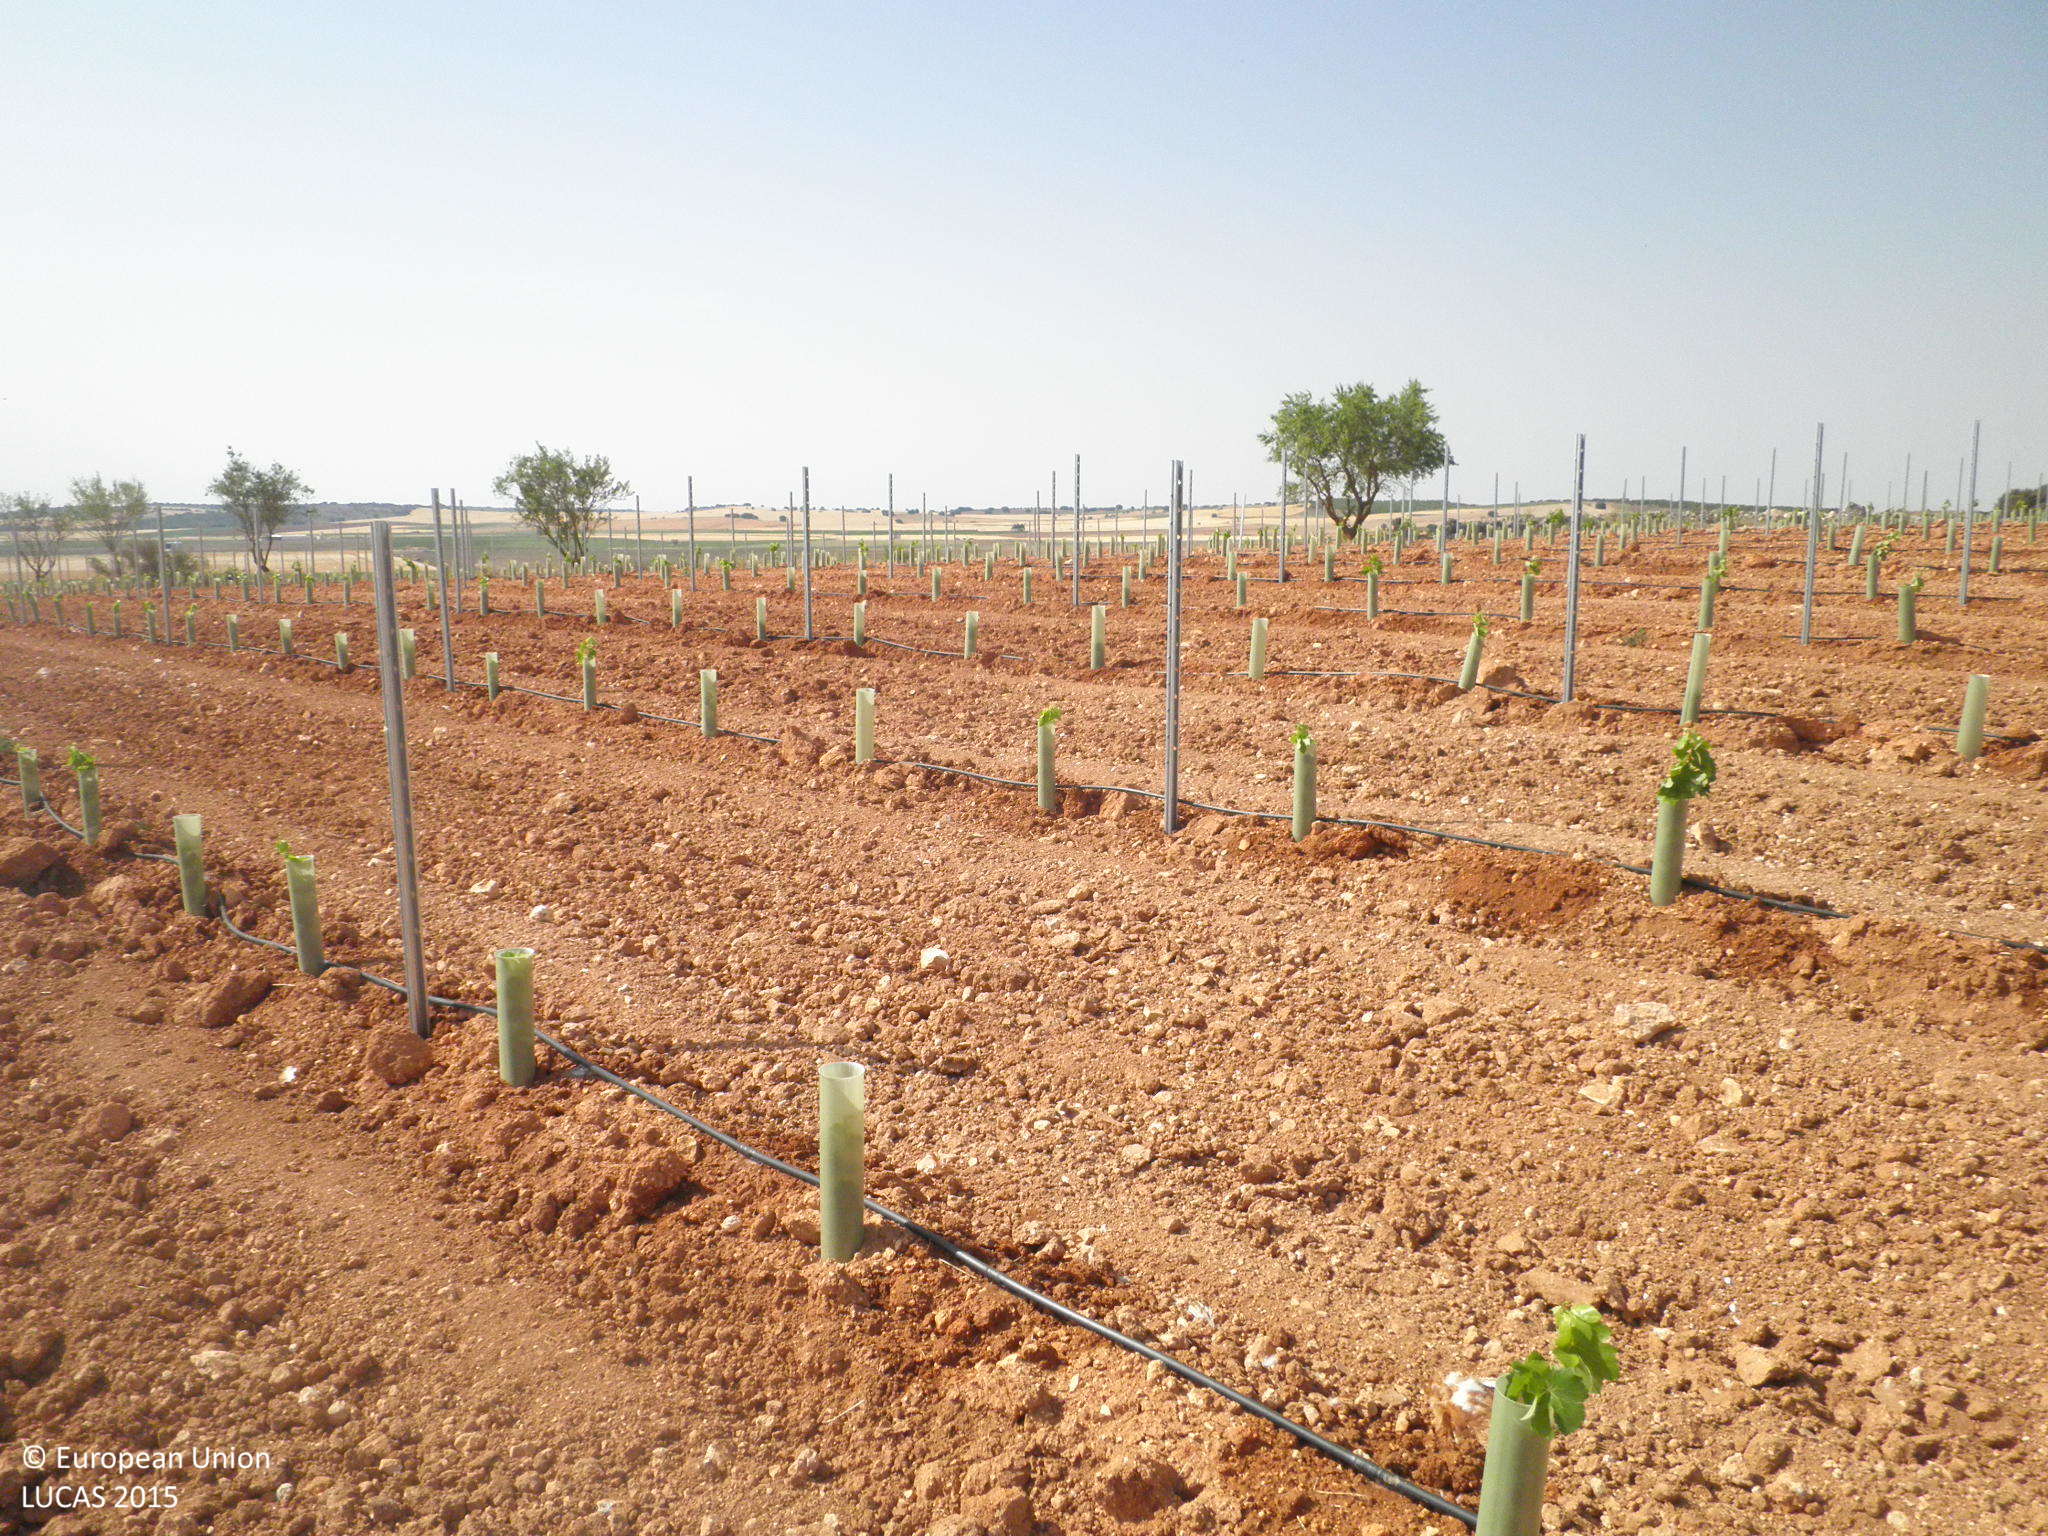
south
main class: Cropland
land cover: Vineyards
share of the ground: < 10 %
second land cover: Other bare soil
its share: > 75 %
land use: Agriculture (excluding fallow land and kitchen gardens)
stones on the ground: 10 - 25 %
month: July
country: ES
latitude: 39.6301
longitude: -2.6327
